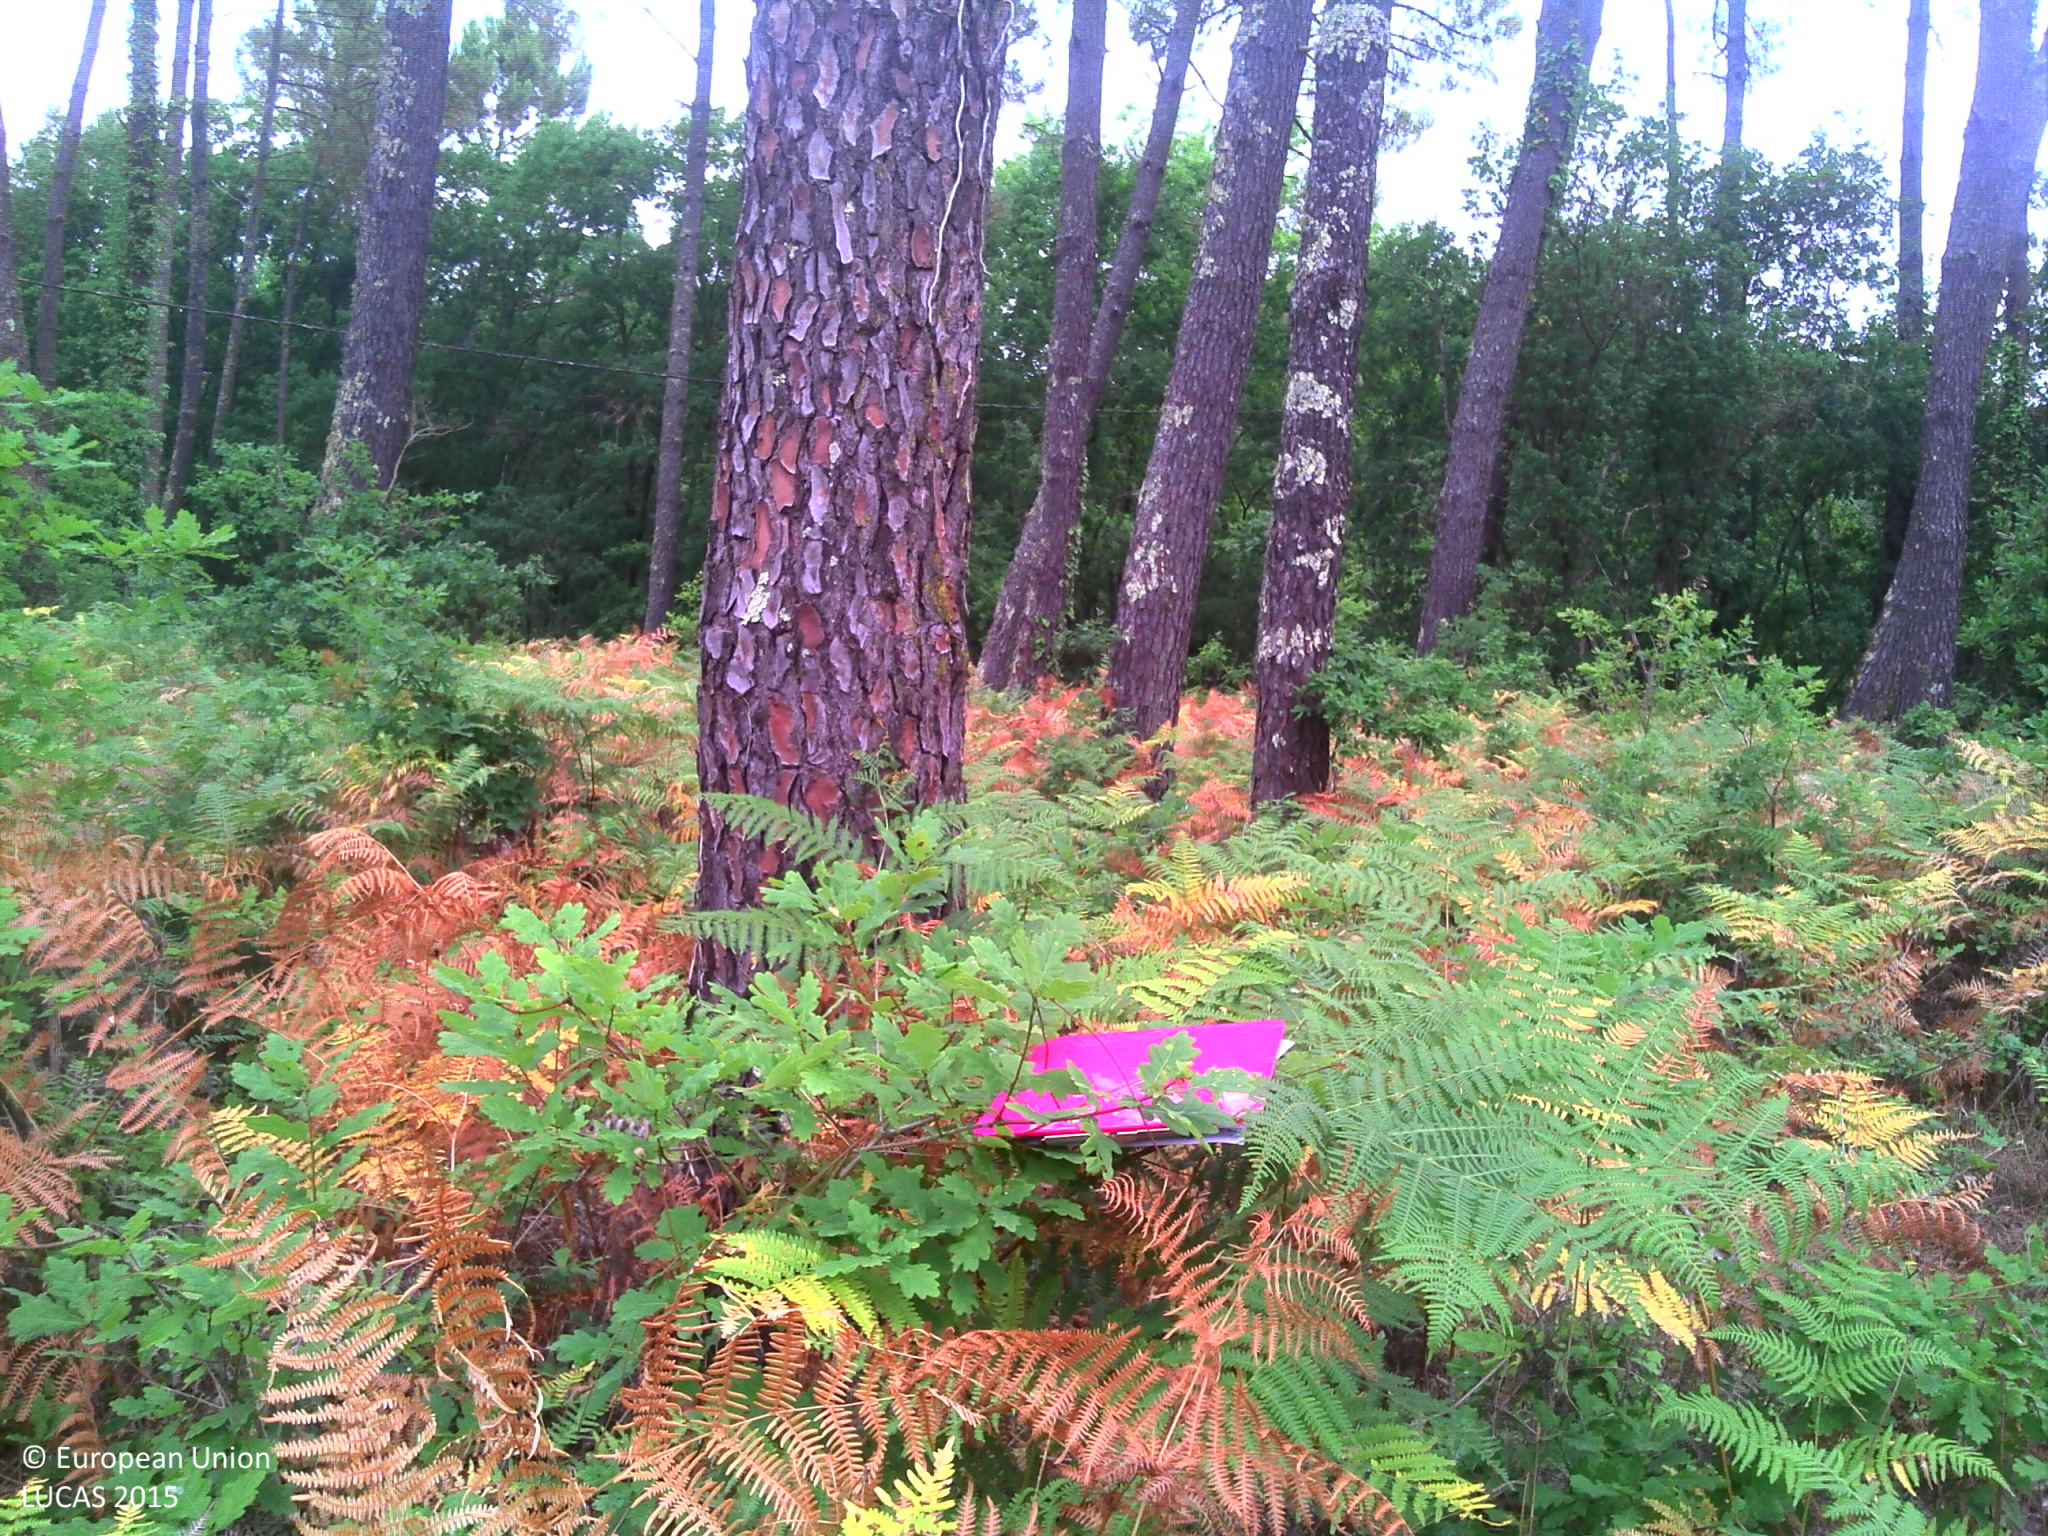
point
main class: Woodland
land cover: Pine dominated coniferous woodland
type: exotic forest
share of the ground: > 75 %
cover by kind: coniferous forest trees 80 %, herbaceous plants 20 %
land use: Forestry
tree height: > 5 m
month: July
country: FR
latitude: 44.3536
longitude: -1.0984
